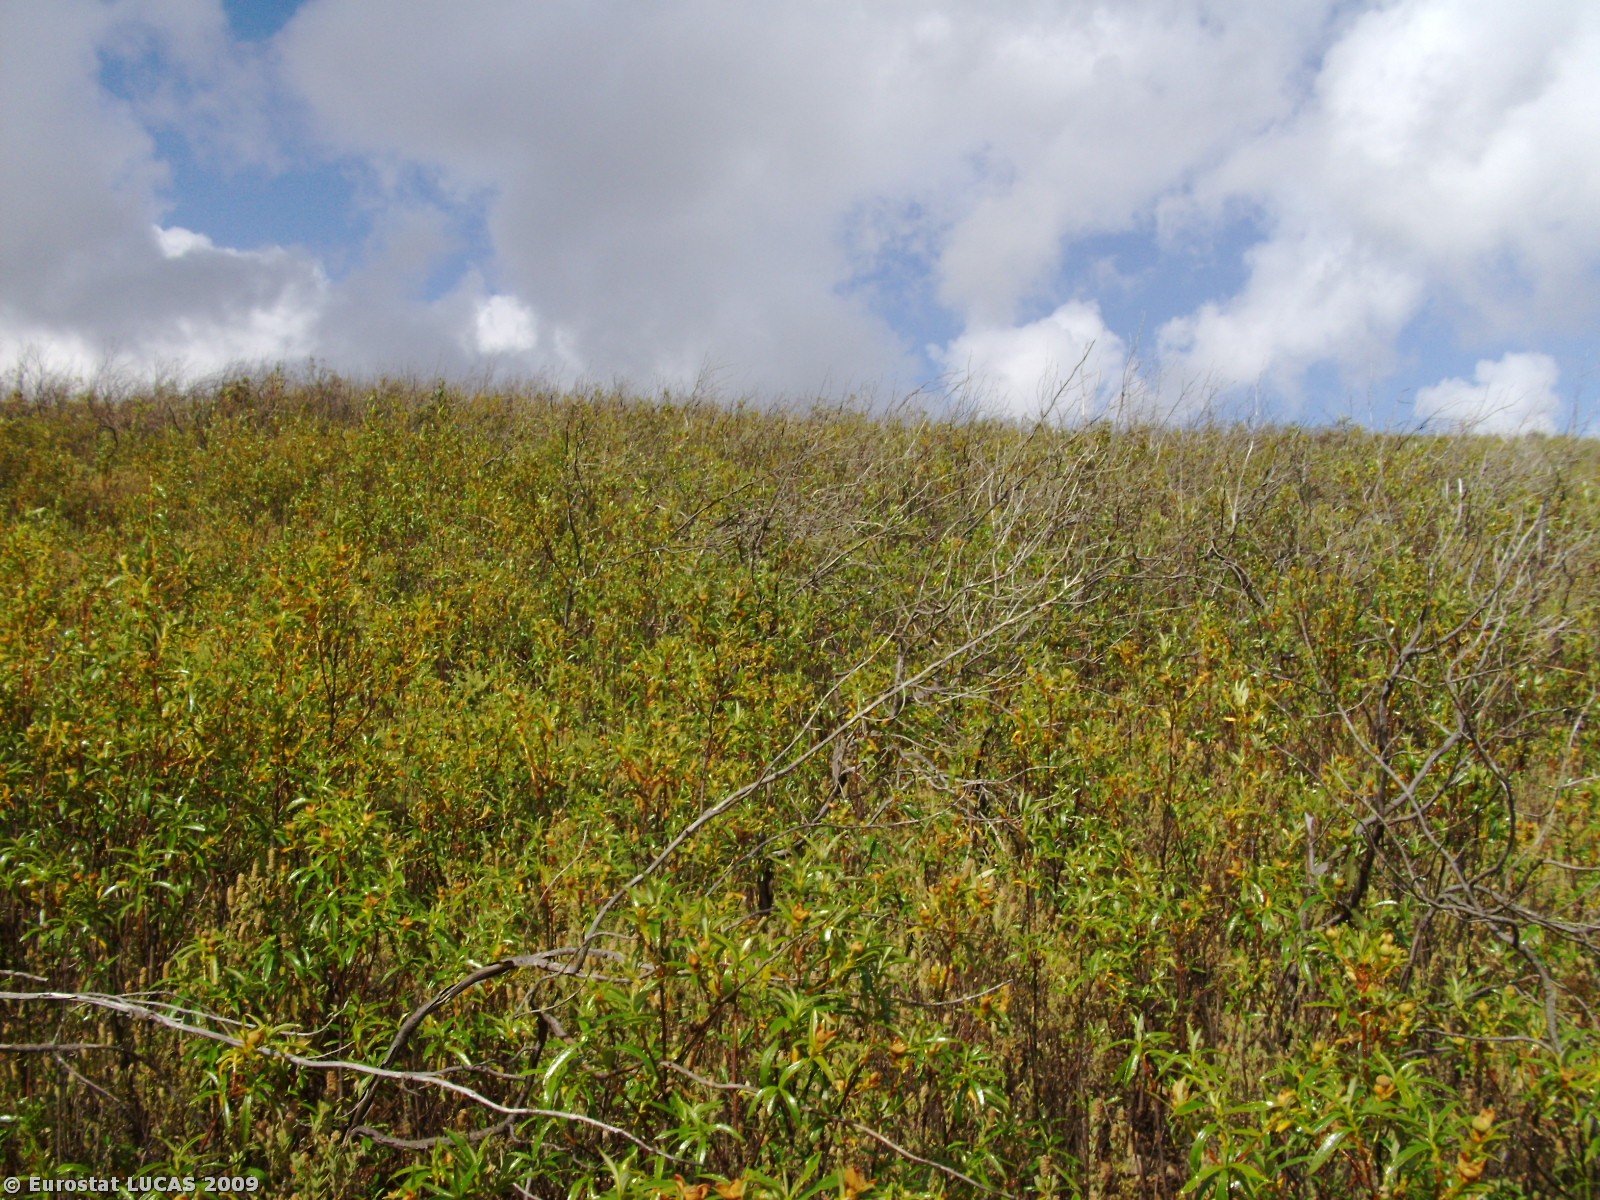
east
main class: Shrubland
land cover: Shrubland without tree cover
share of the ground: > 75 %
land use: Unused
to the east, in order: Shrubland without tree cover; Other structural elements; Shruby margins; Tracks; Shrubland with sparse tree cover; Tracks; Shrubland with sparse tree cover
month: June
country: PT
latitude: 37.2050
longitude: -8.7241
